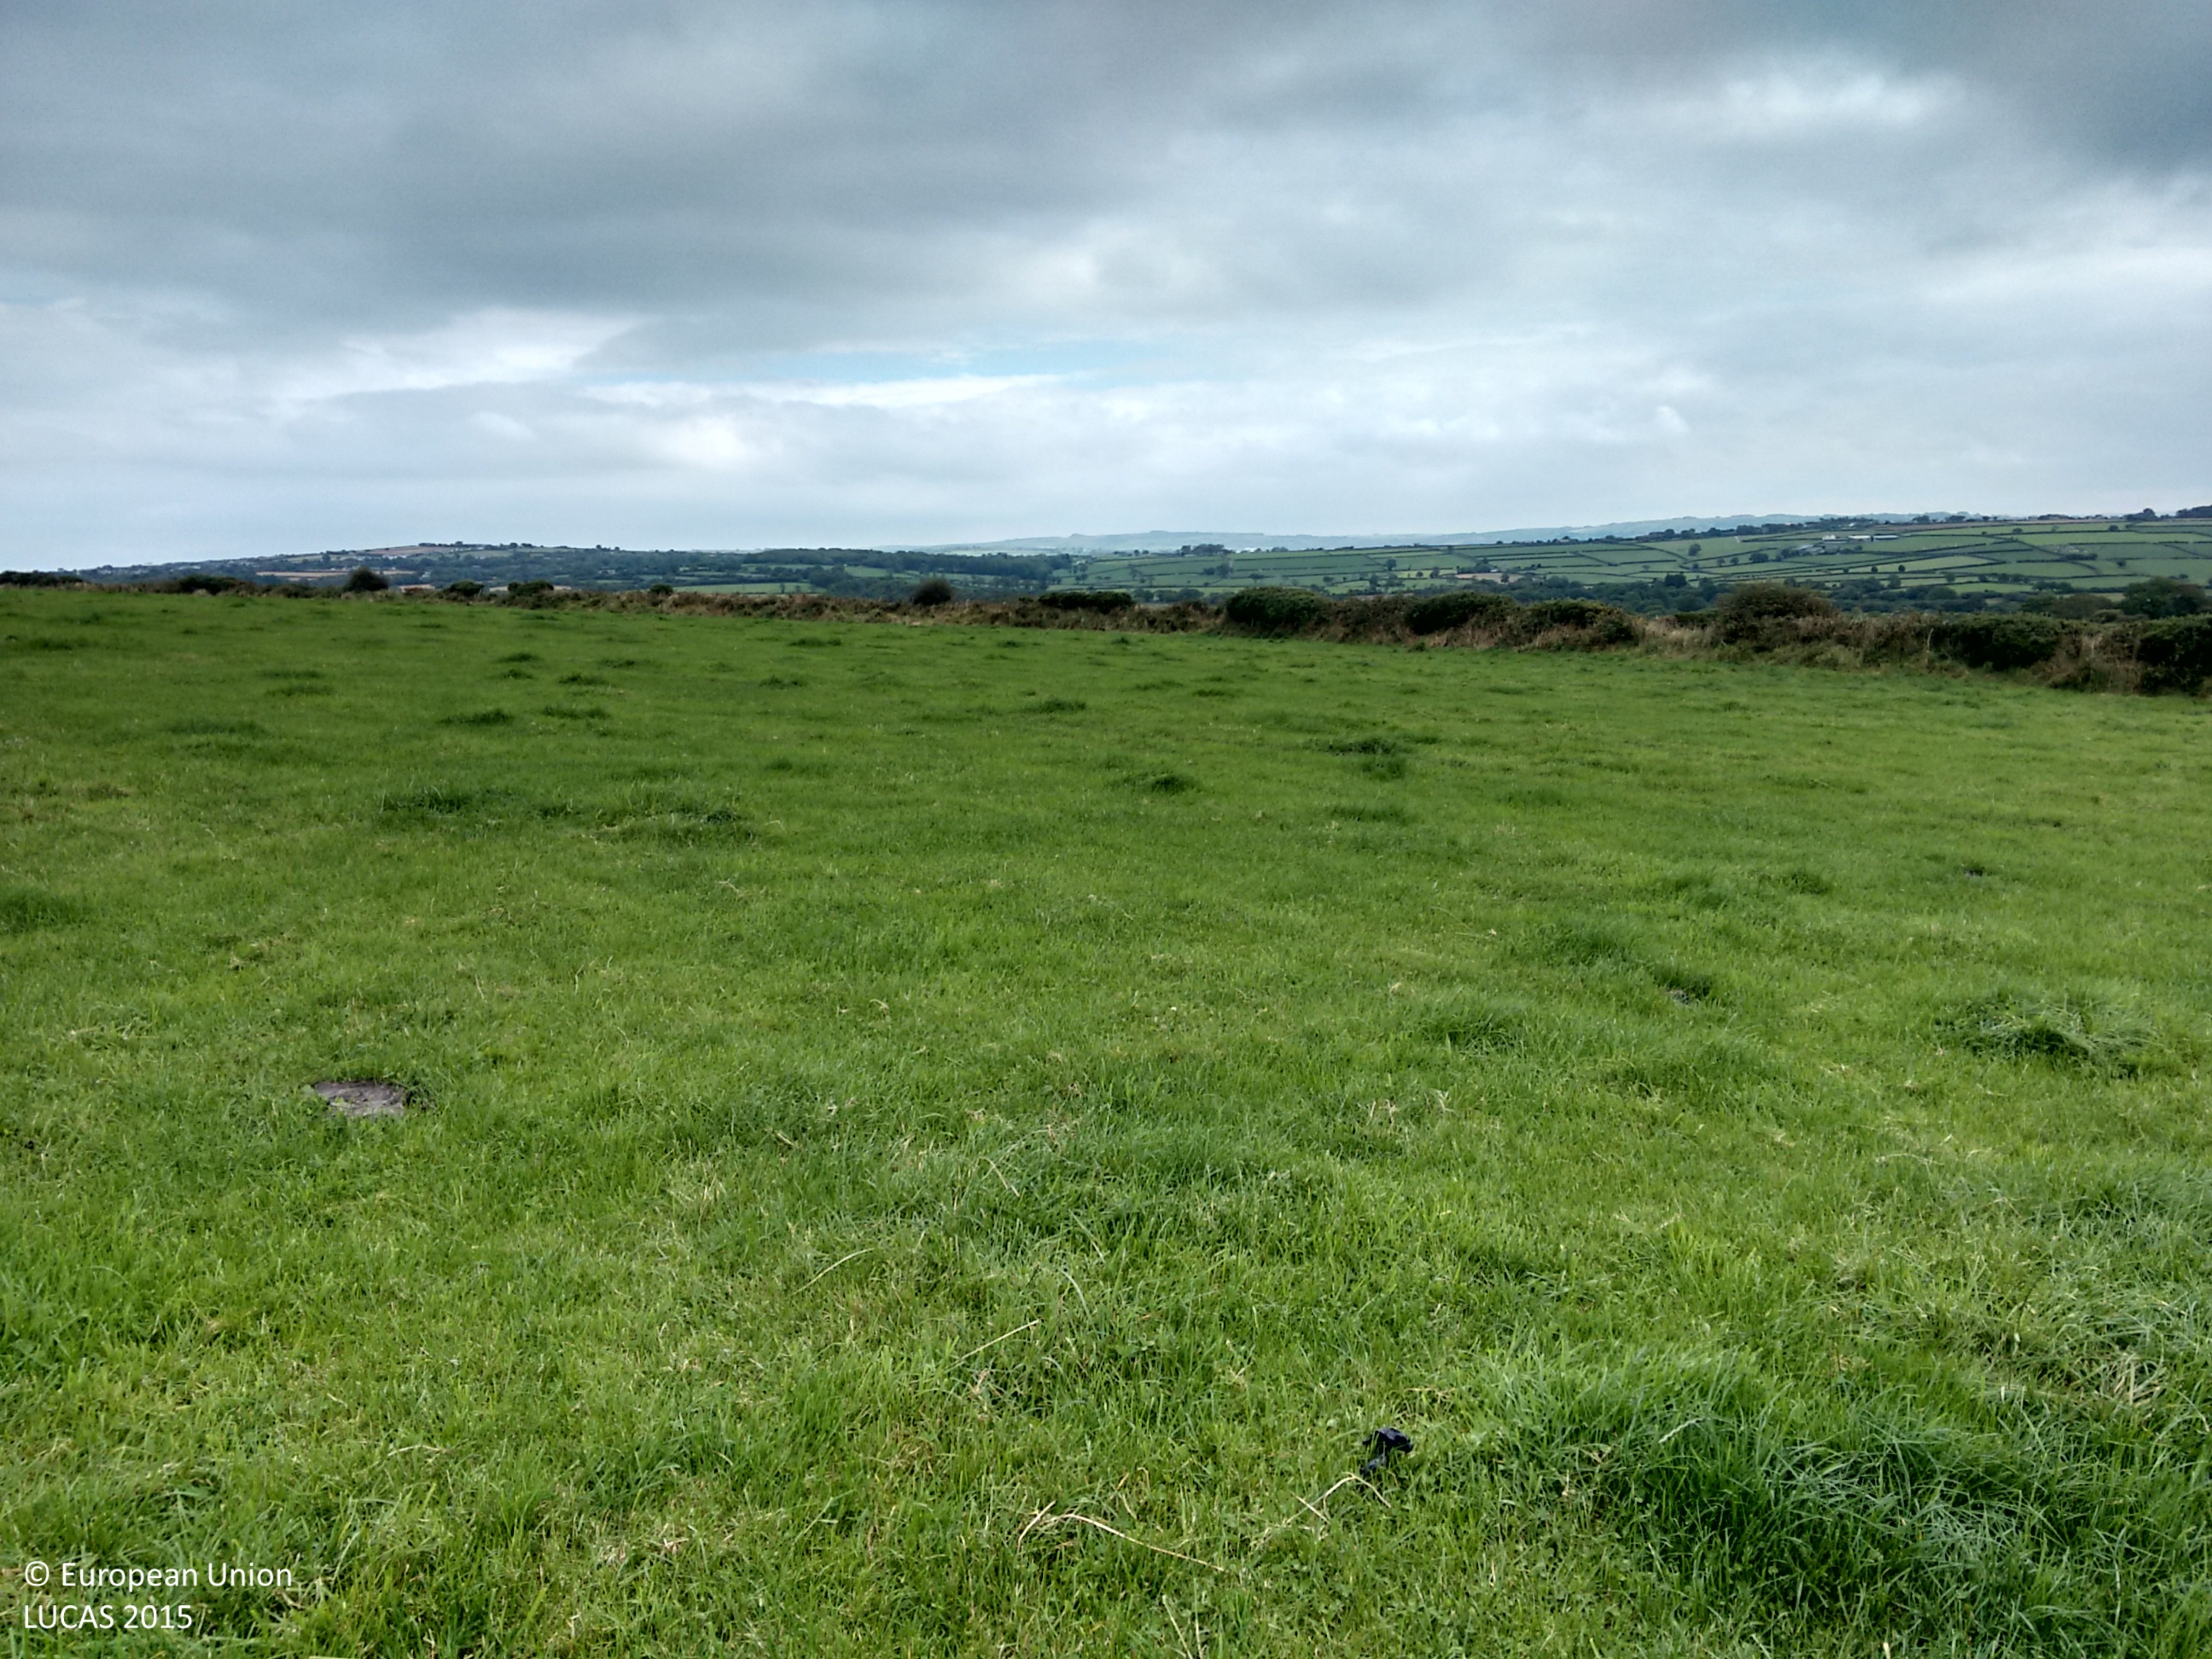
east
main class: Grassland
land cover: Grassland without tree/shrub cover
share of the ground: > 75 %
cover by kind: herbaceous plants 100 %
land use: Agriculture (excluding fallow land and kitchen gardens)
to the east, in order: Grassland without tree/shrub cover; Fences; Managed hedges; Grassland without tree/shrub cover; Fences; Managed hedges; Grassland without tree/shrub cover
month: September
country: GB
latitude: 52.0969
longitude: -4.5433
